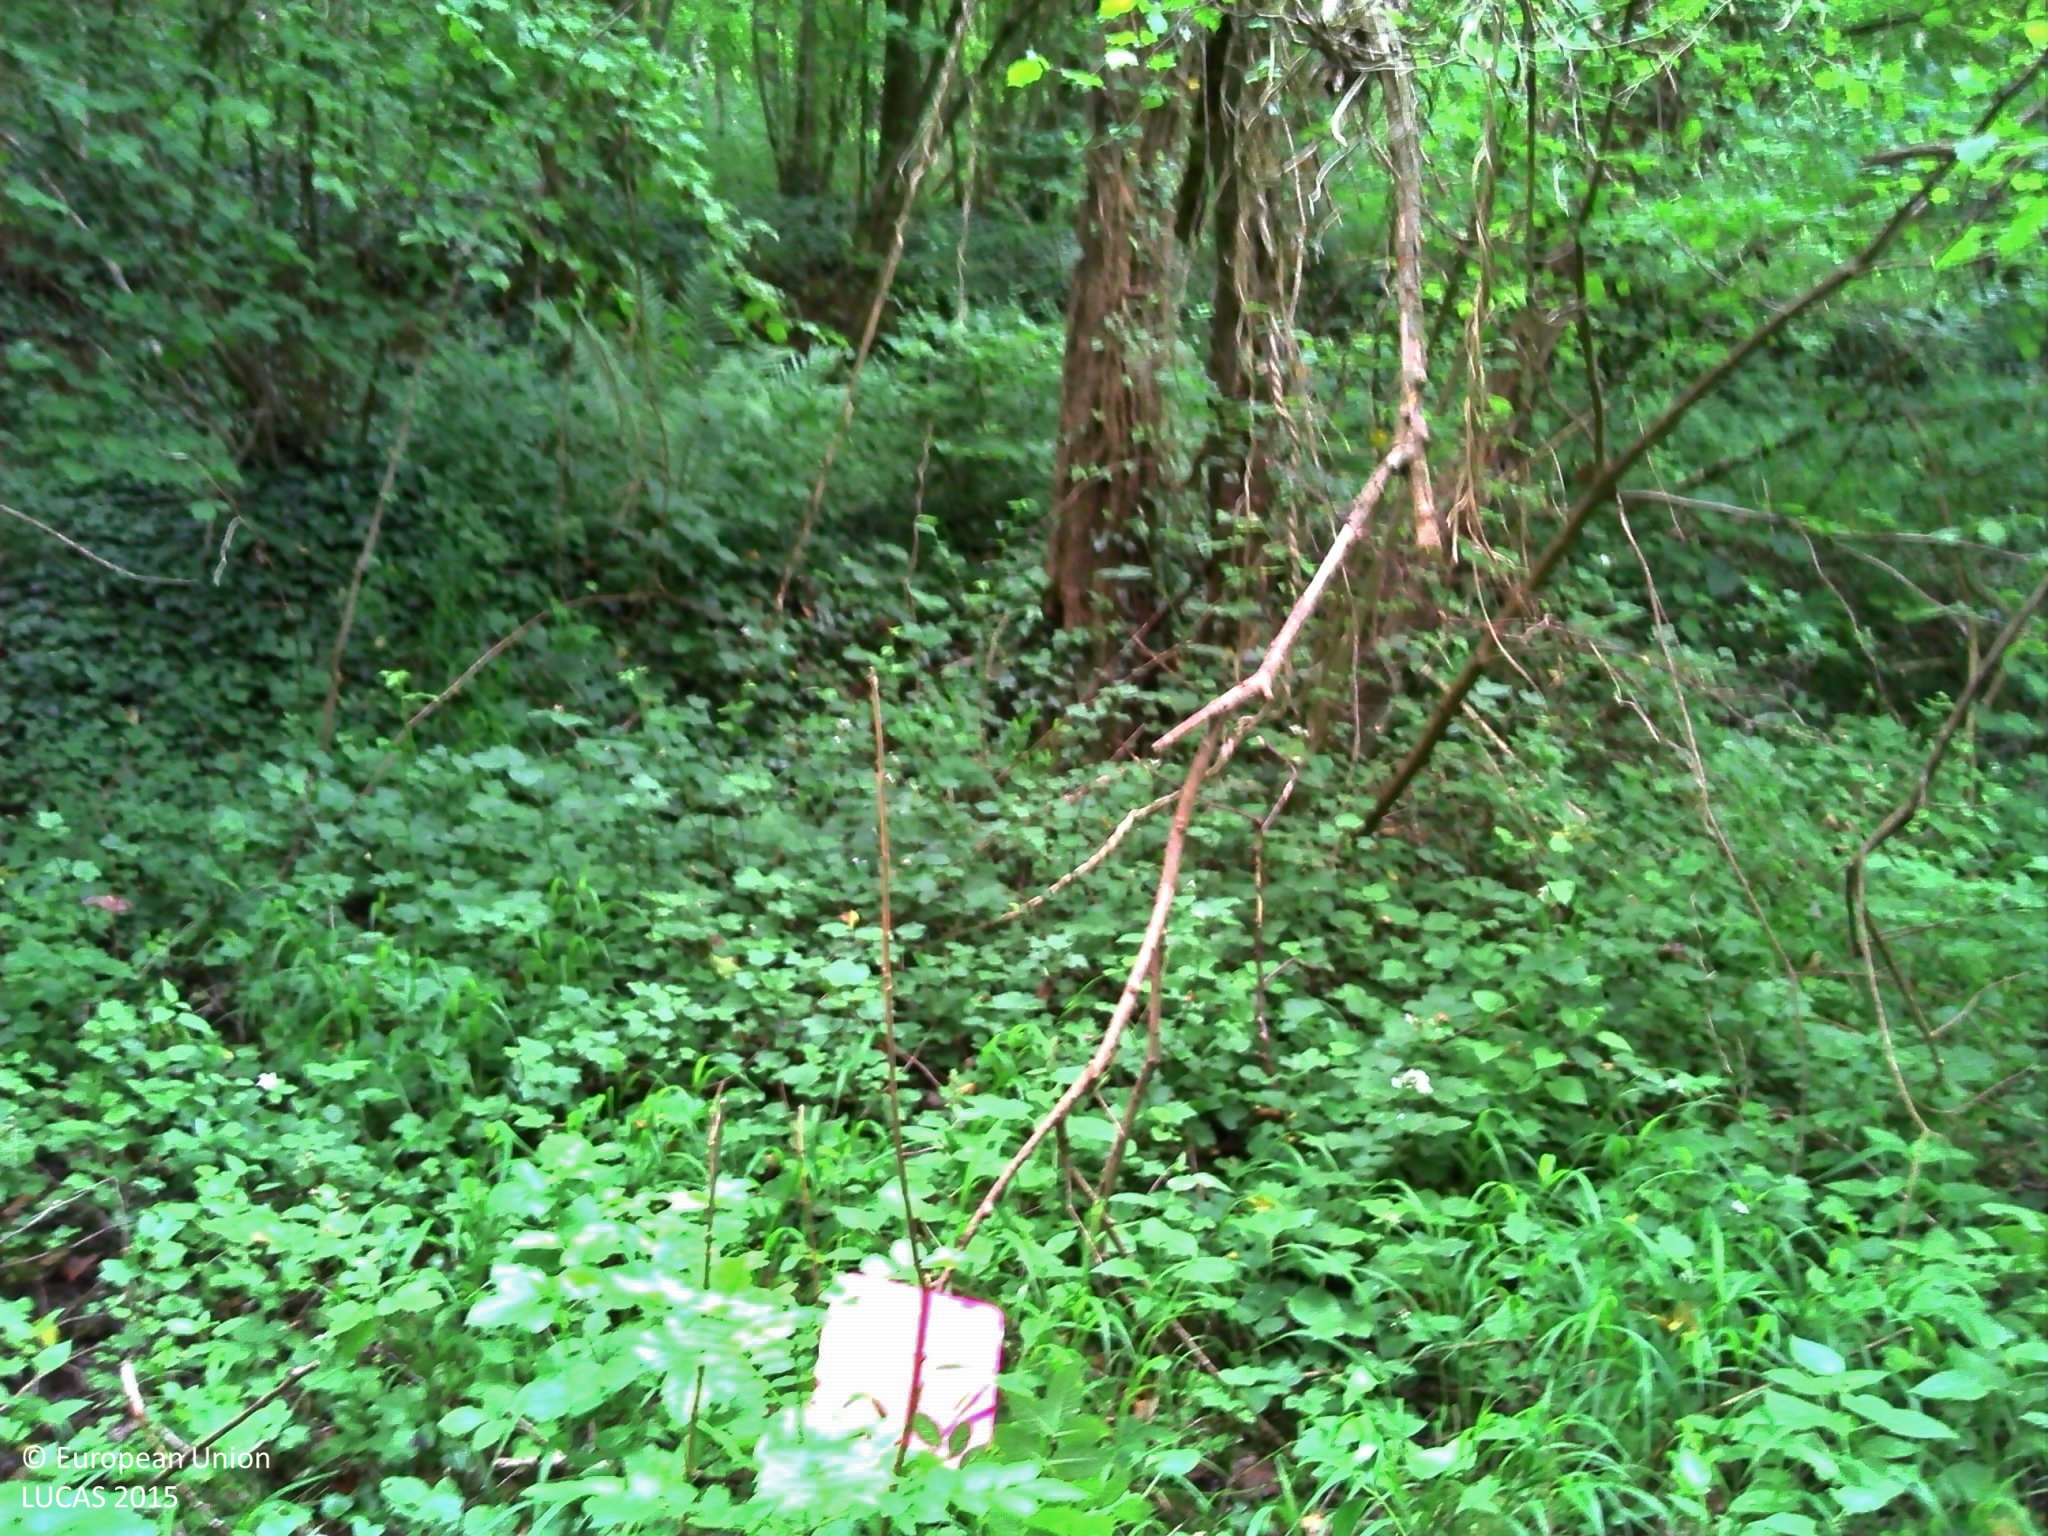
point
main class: Woodland
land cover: Broadleaved woodland
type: mesophytic deciduous forest
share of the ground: > 75 %
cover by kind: broadleaved forest trees 85 %, shrubs 10 %, herbaceous plants 5 %
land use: Forestry
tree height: > 5 m
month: June
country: FR
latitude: 49.2613
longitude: 2.9414
